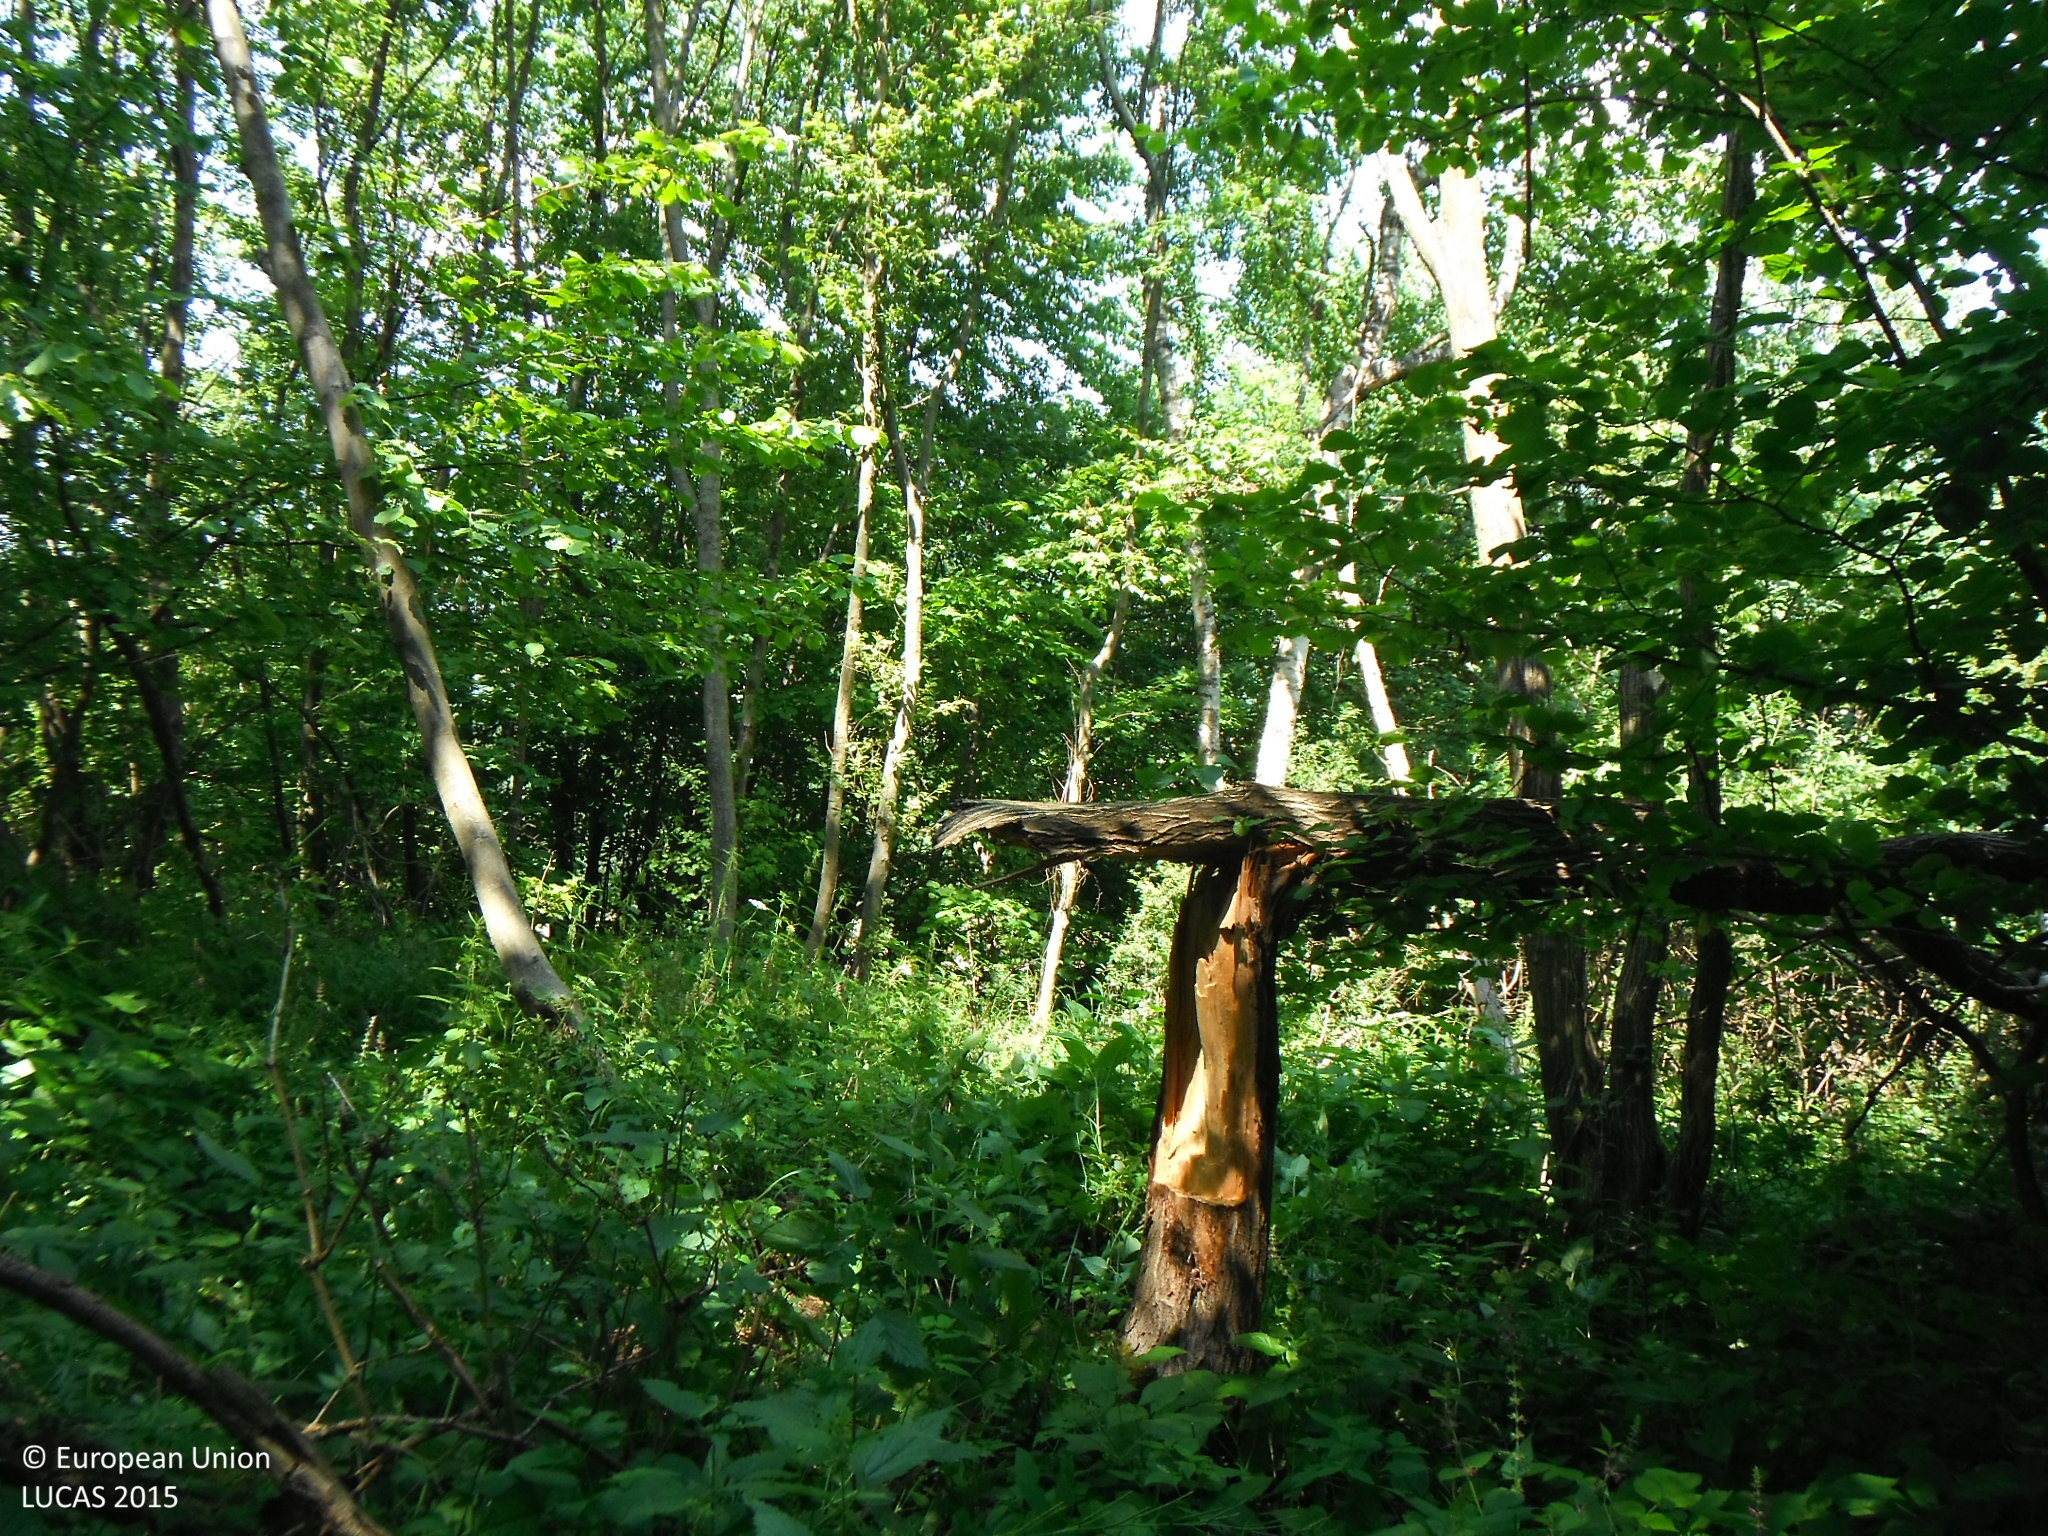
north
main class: Woodland
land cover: Broadleaved woodland
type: mesophytic deciduous forest
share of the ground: > 75 %
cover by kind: broadleaved forest trees 90 %, herbaceous plants 10 %
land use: Forestry
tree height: > 5 m
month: July
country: SK
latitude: 49.3856
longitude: 21.1060
